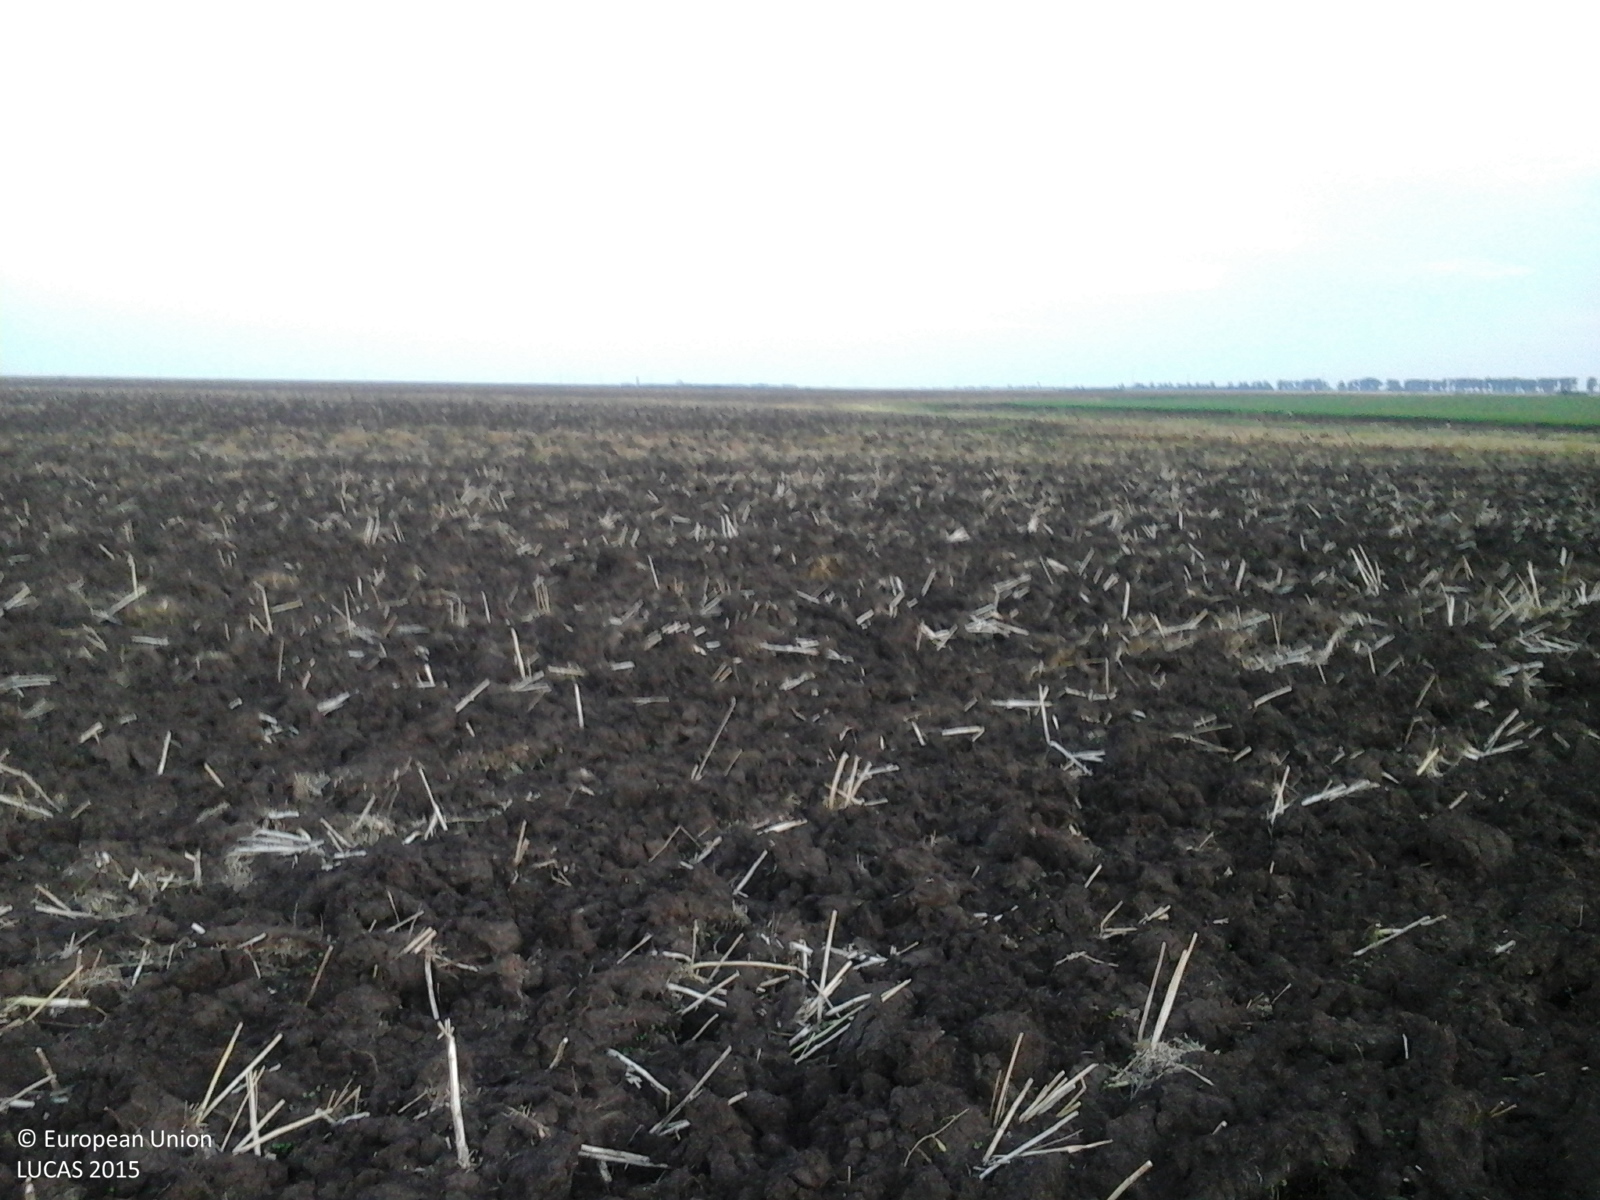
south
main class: Cropland
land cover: Rape and turnip rape
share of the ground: < 10 %
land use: Agriculture (excluding fallow land and kitchen gardens)
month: July
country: RO
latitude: 44.0486
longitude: 25.6802
